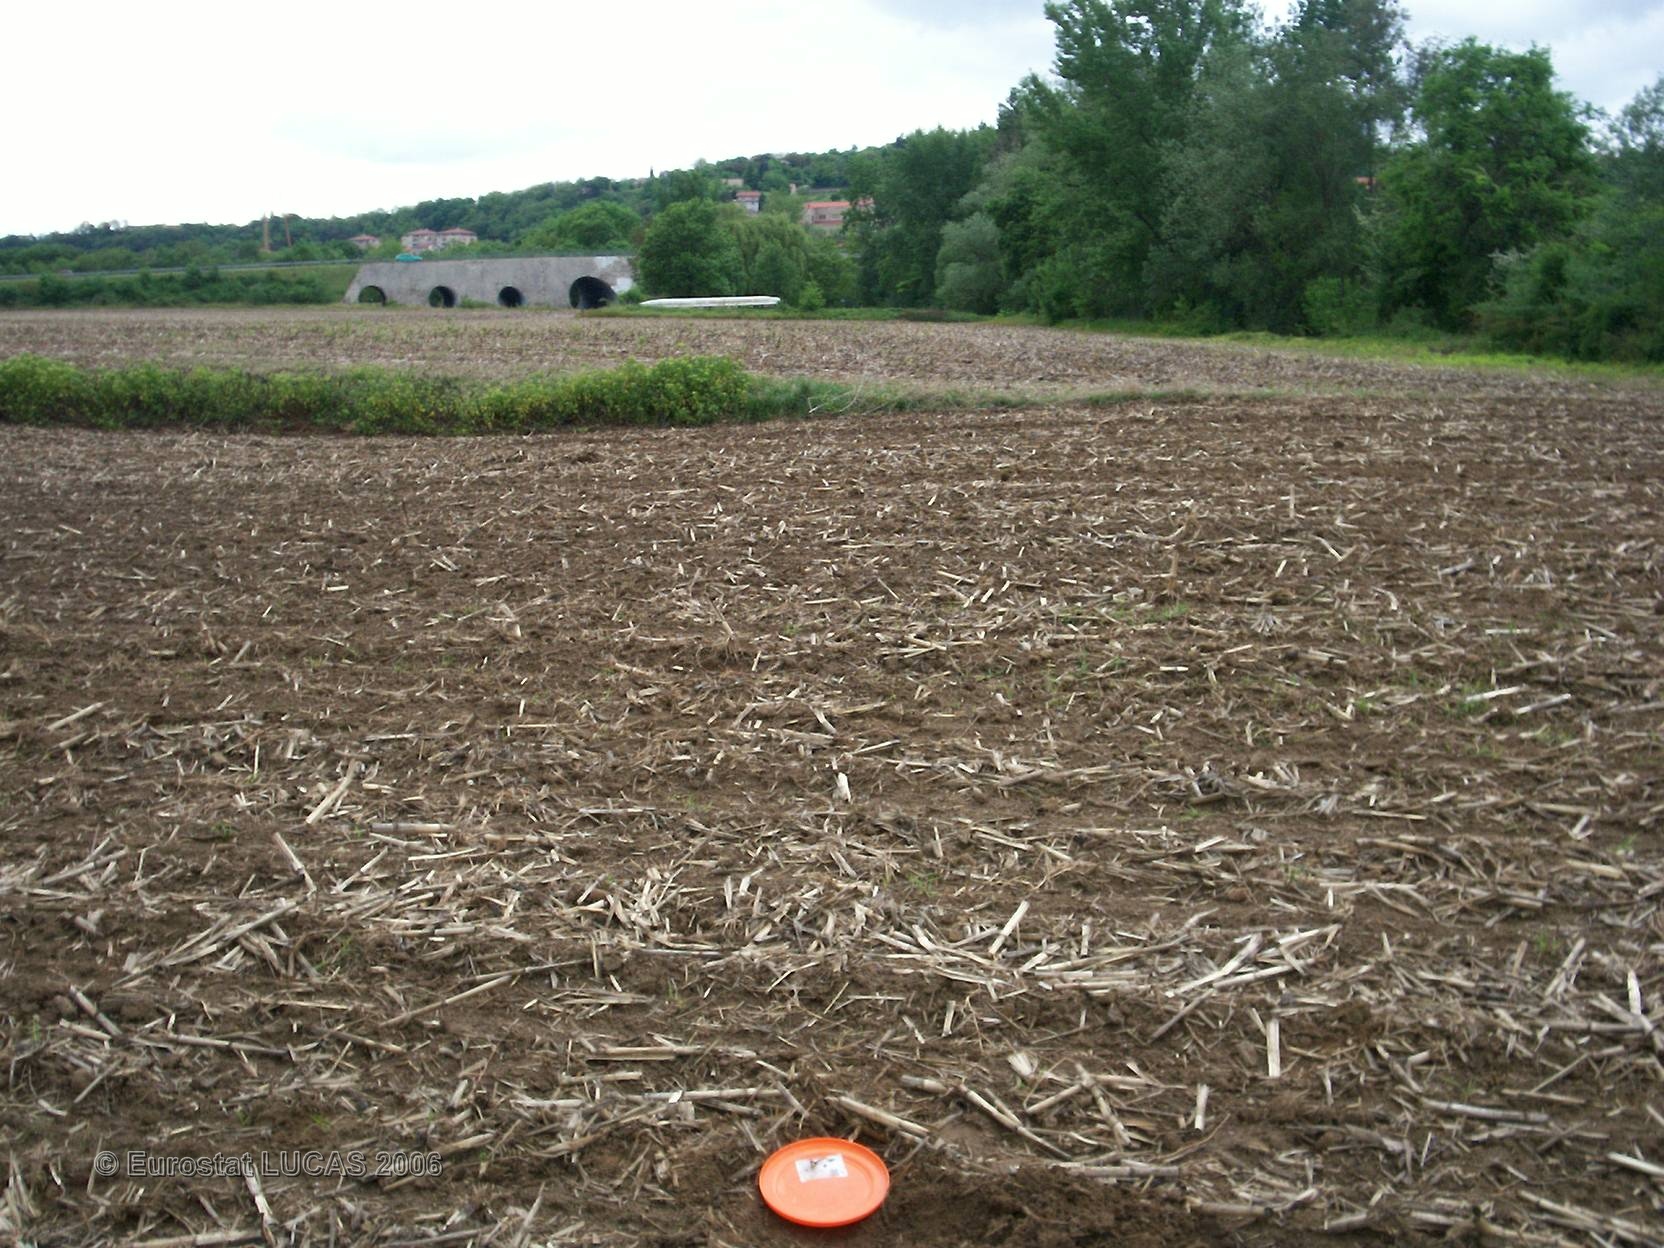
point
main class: Cropland
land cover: Maize
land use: Agriculture (excluding fallow land and kitchen gardens)
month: May
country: FR
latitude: 45.9350
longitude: 4.7797
